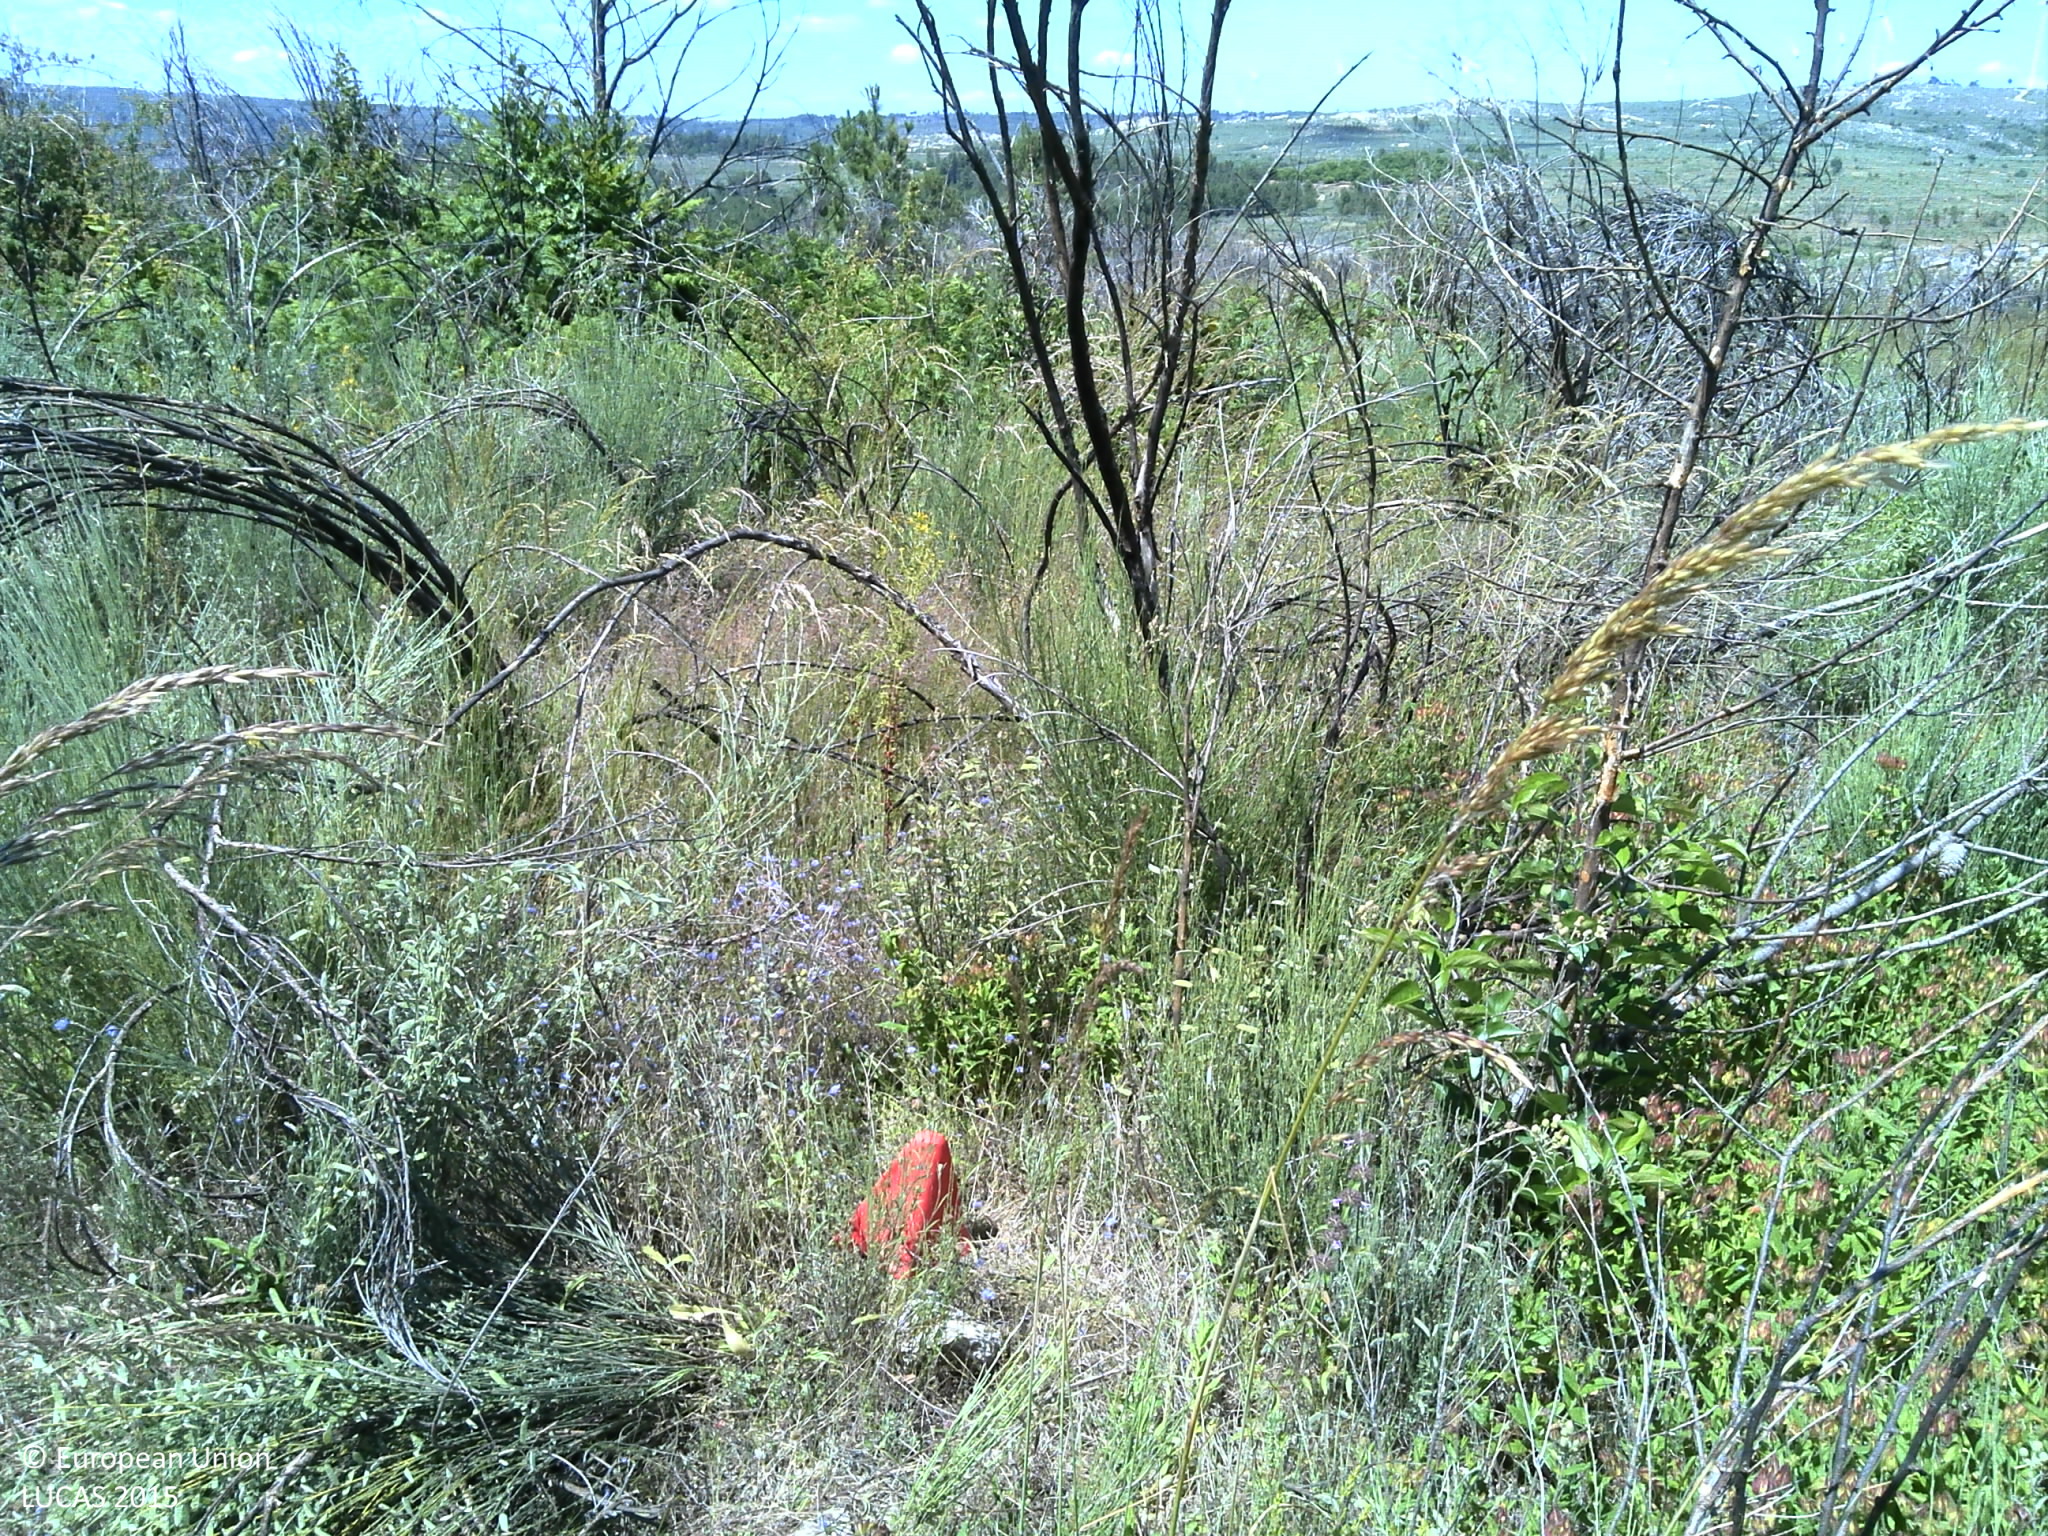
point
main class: Shrubland
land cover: Shrubland with sparse tree cover
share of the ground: 25 - 50 %
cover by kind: shrubs 40 %, unconsolidated bare surface 25 %, herbaceous plants 20 %, consolidated bare surface 10 %, broadleaved forest trees 5 %
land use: Forestry
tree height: < 5 m
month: June
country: PT
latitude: 41.0301
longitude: -7.5699
